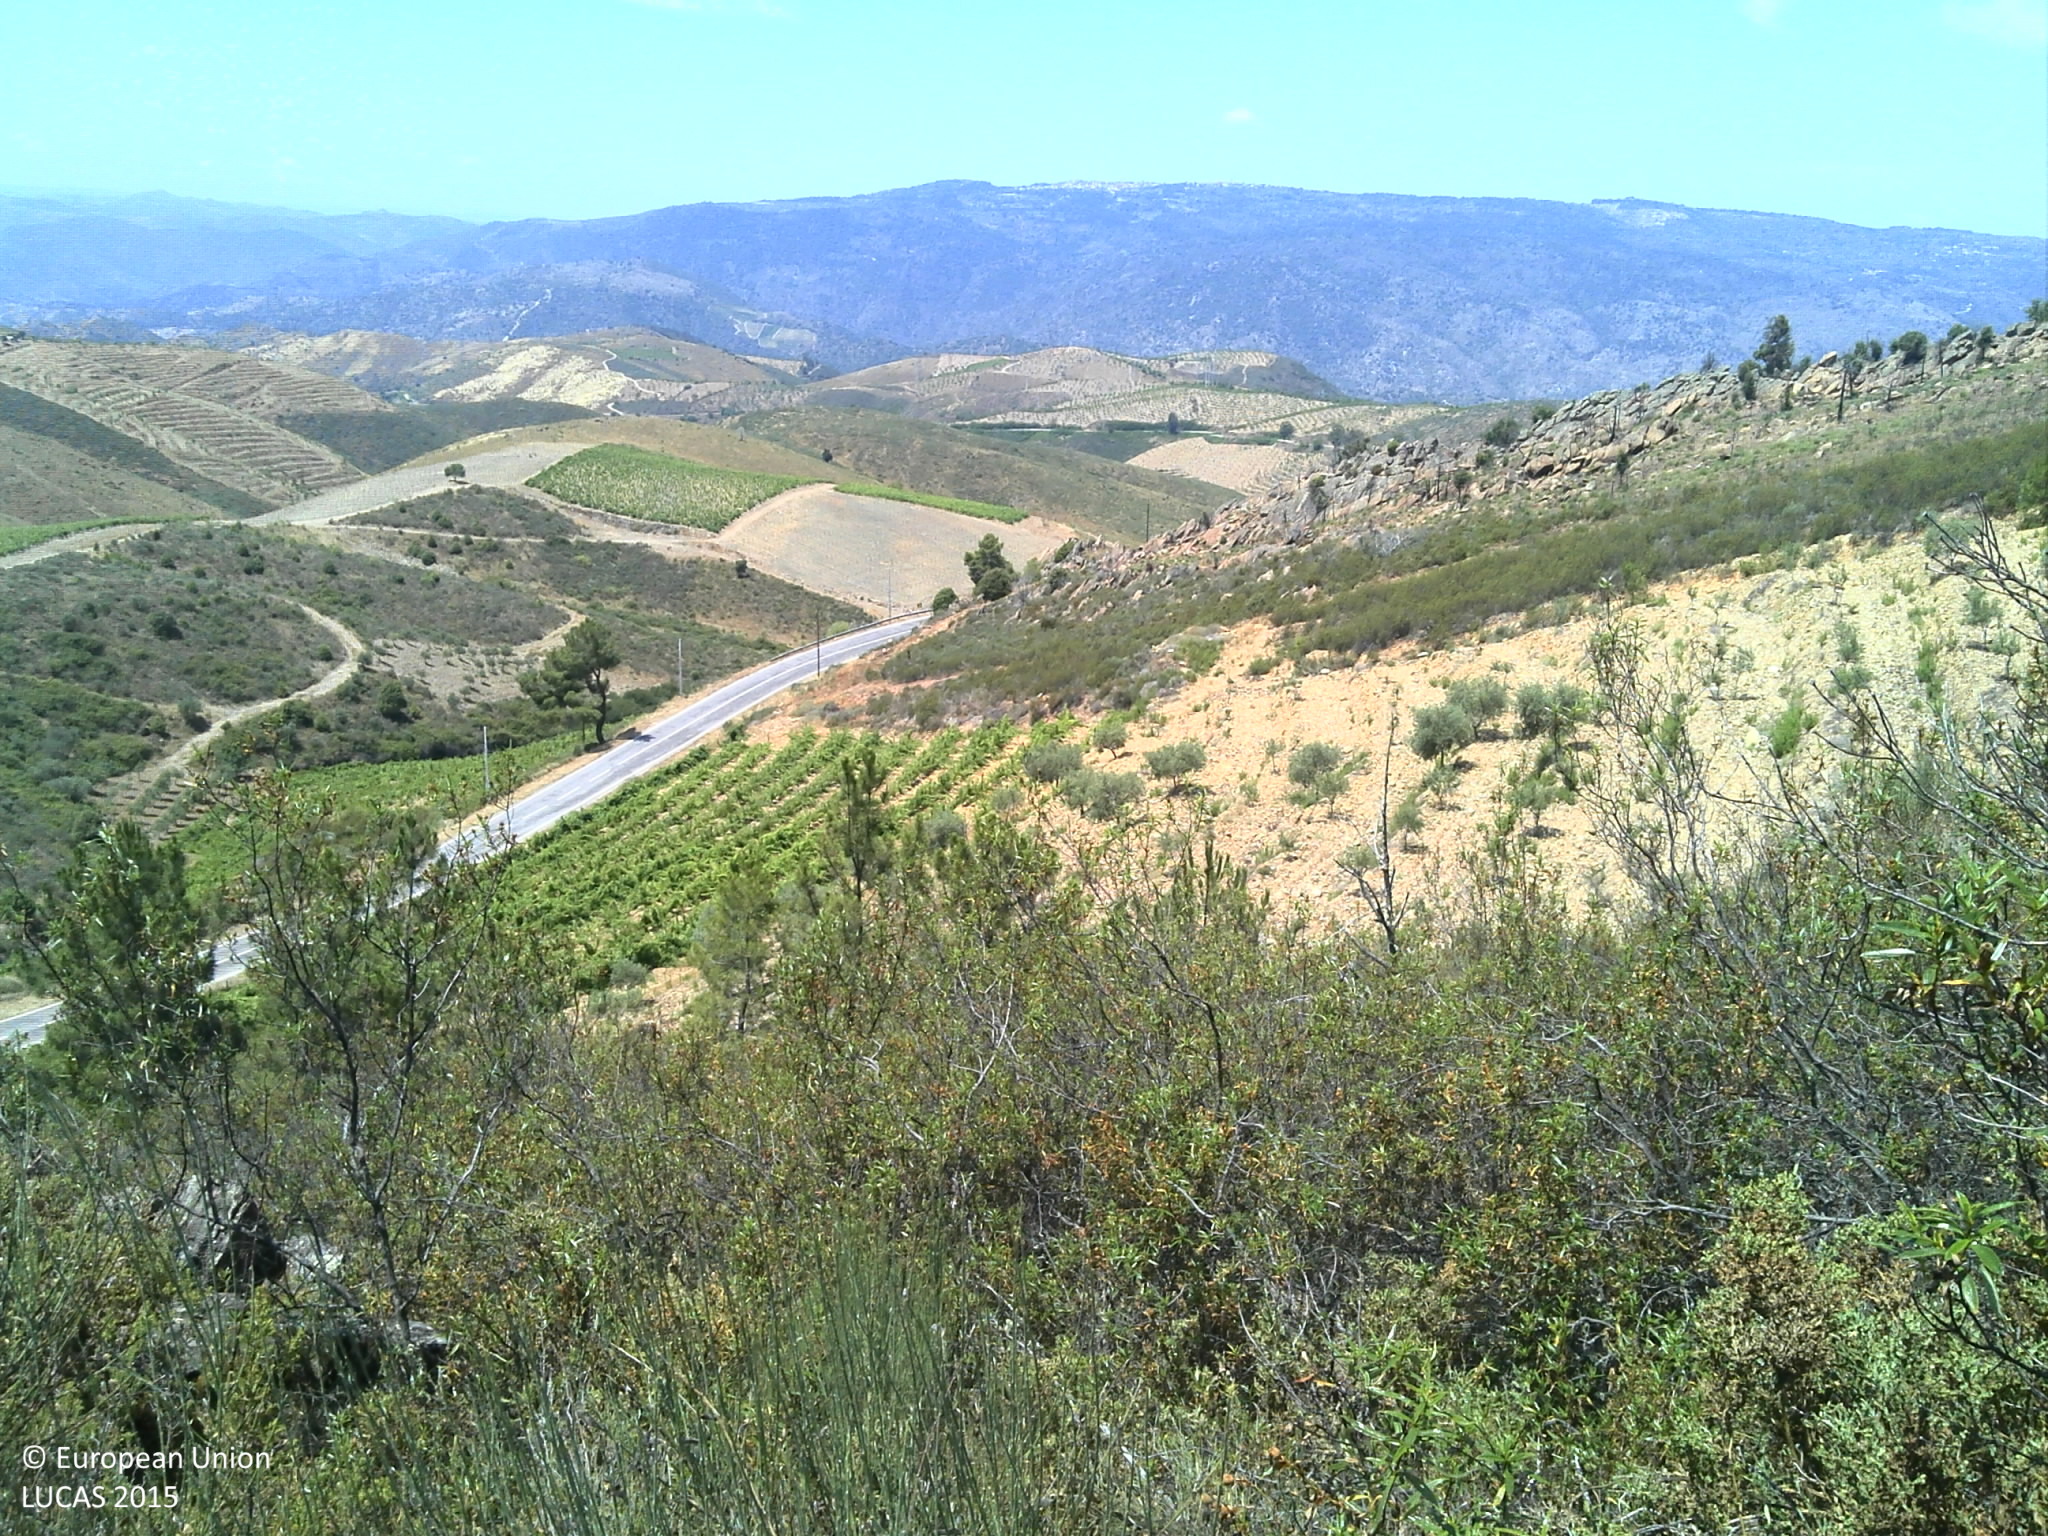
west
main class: Shrubland
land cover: Shrubland without tree cover
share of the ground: > 75 %
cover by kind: shrubs 90 %, consolidated bare surface 5 %, unconsolidated bare surface 5 %
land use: Semi-natural and natural areas not in use
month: June
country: PT
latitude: 41.1558
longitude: -7.0682
